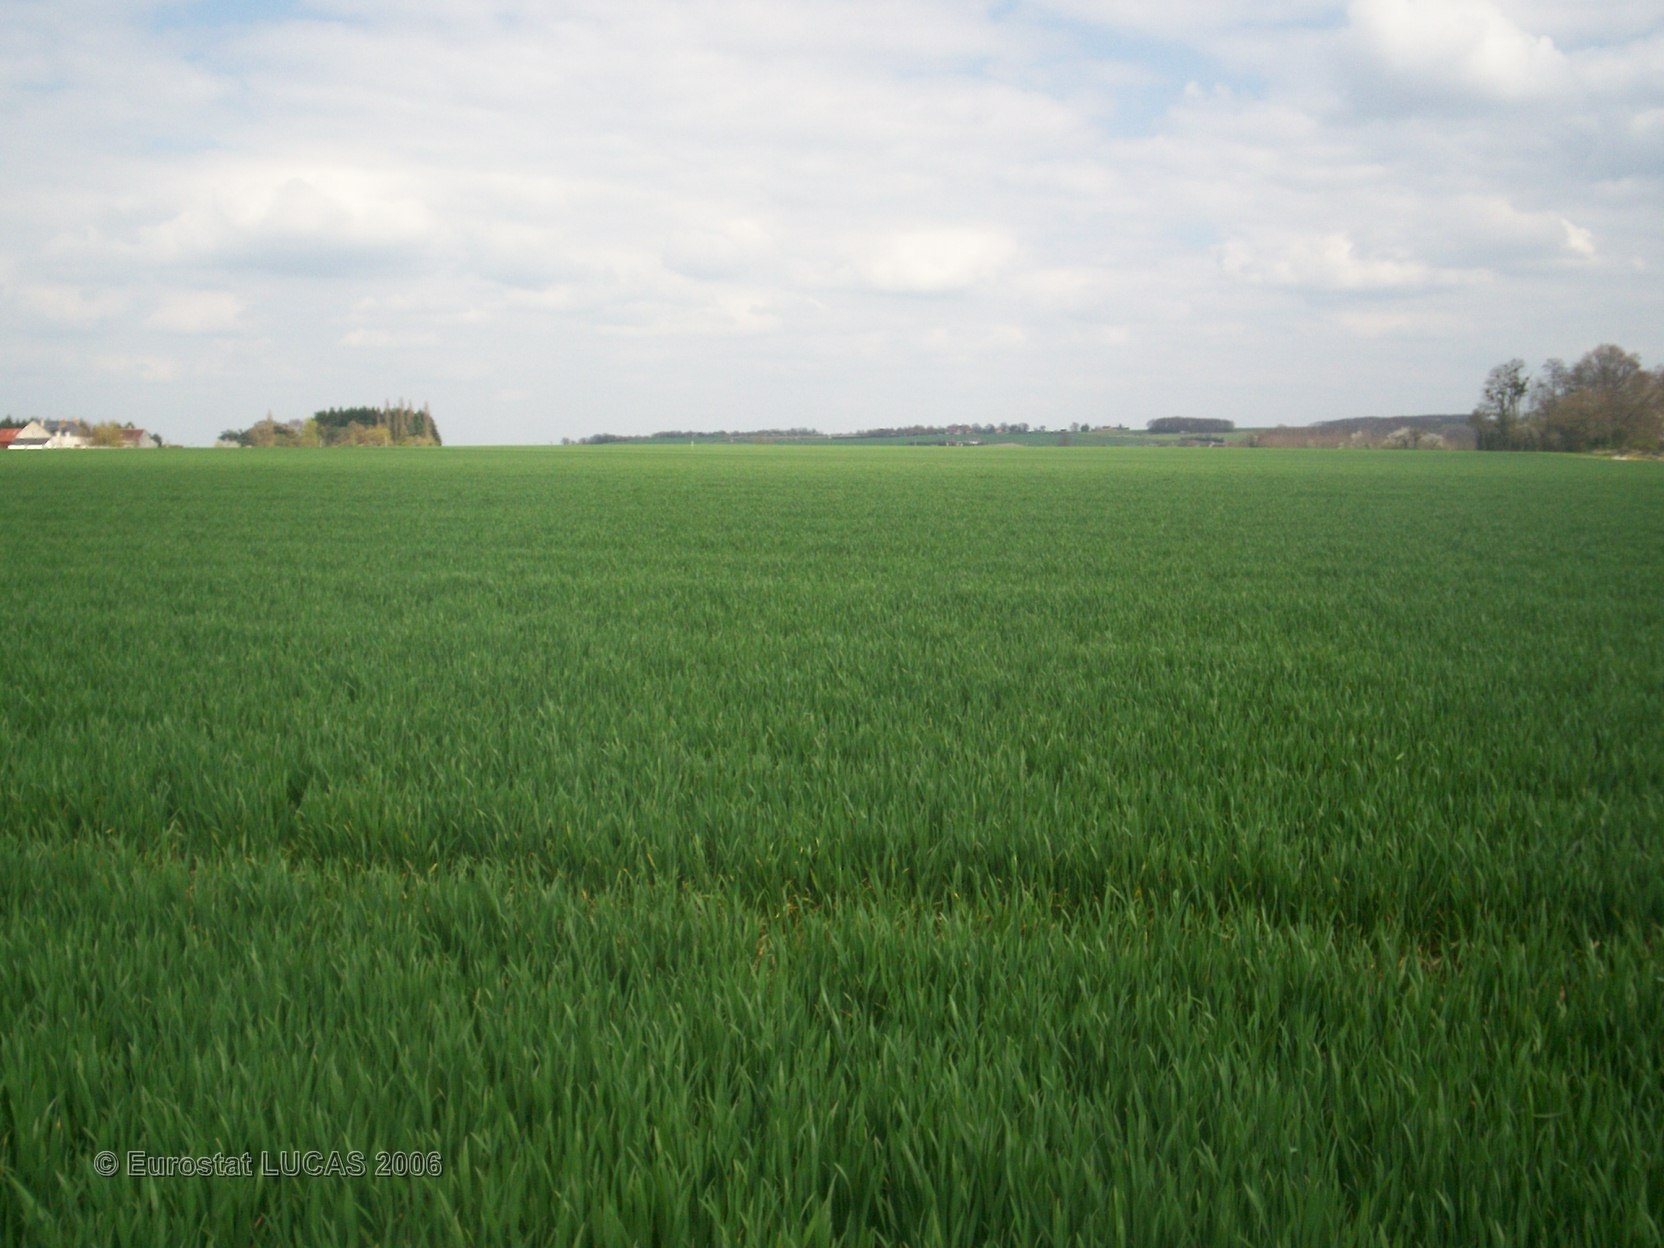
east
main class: Cropland
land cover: Common wheat
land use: Agriculture (excluding fallow land and kitchen gardens)
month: April
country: FR
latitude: 47.7490
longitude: 0.8169
